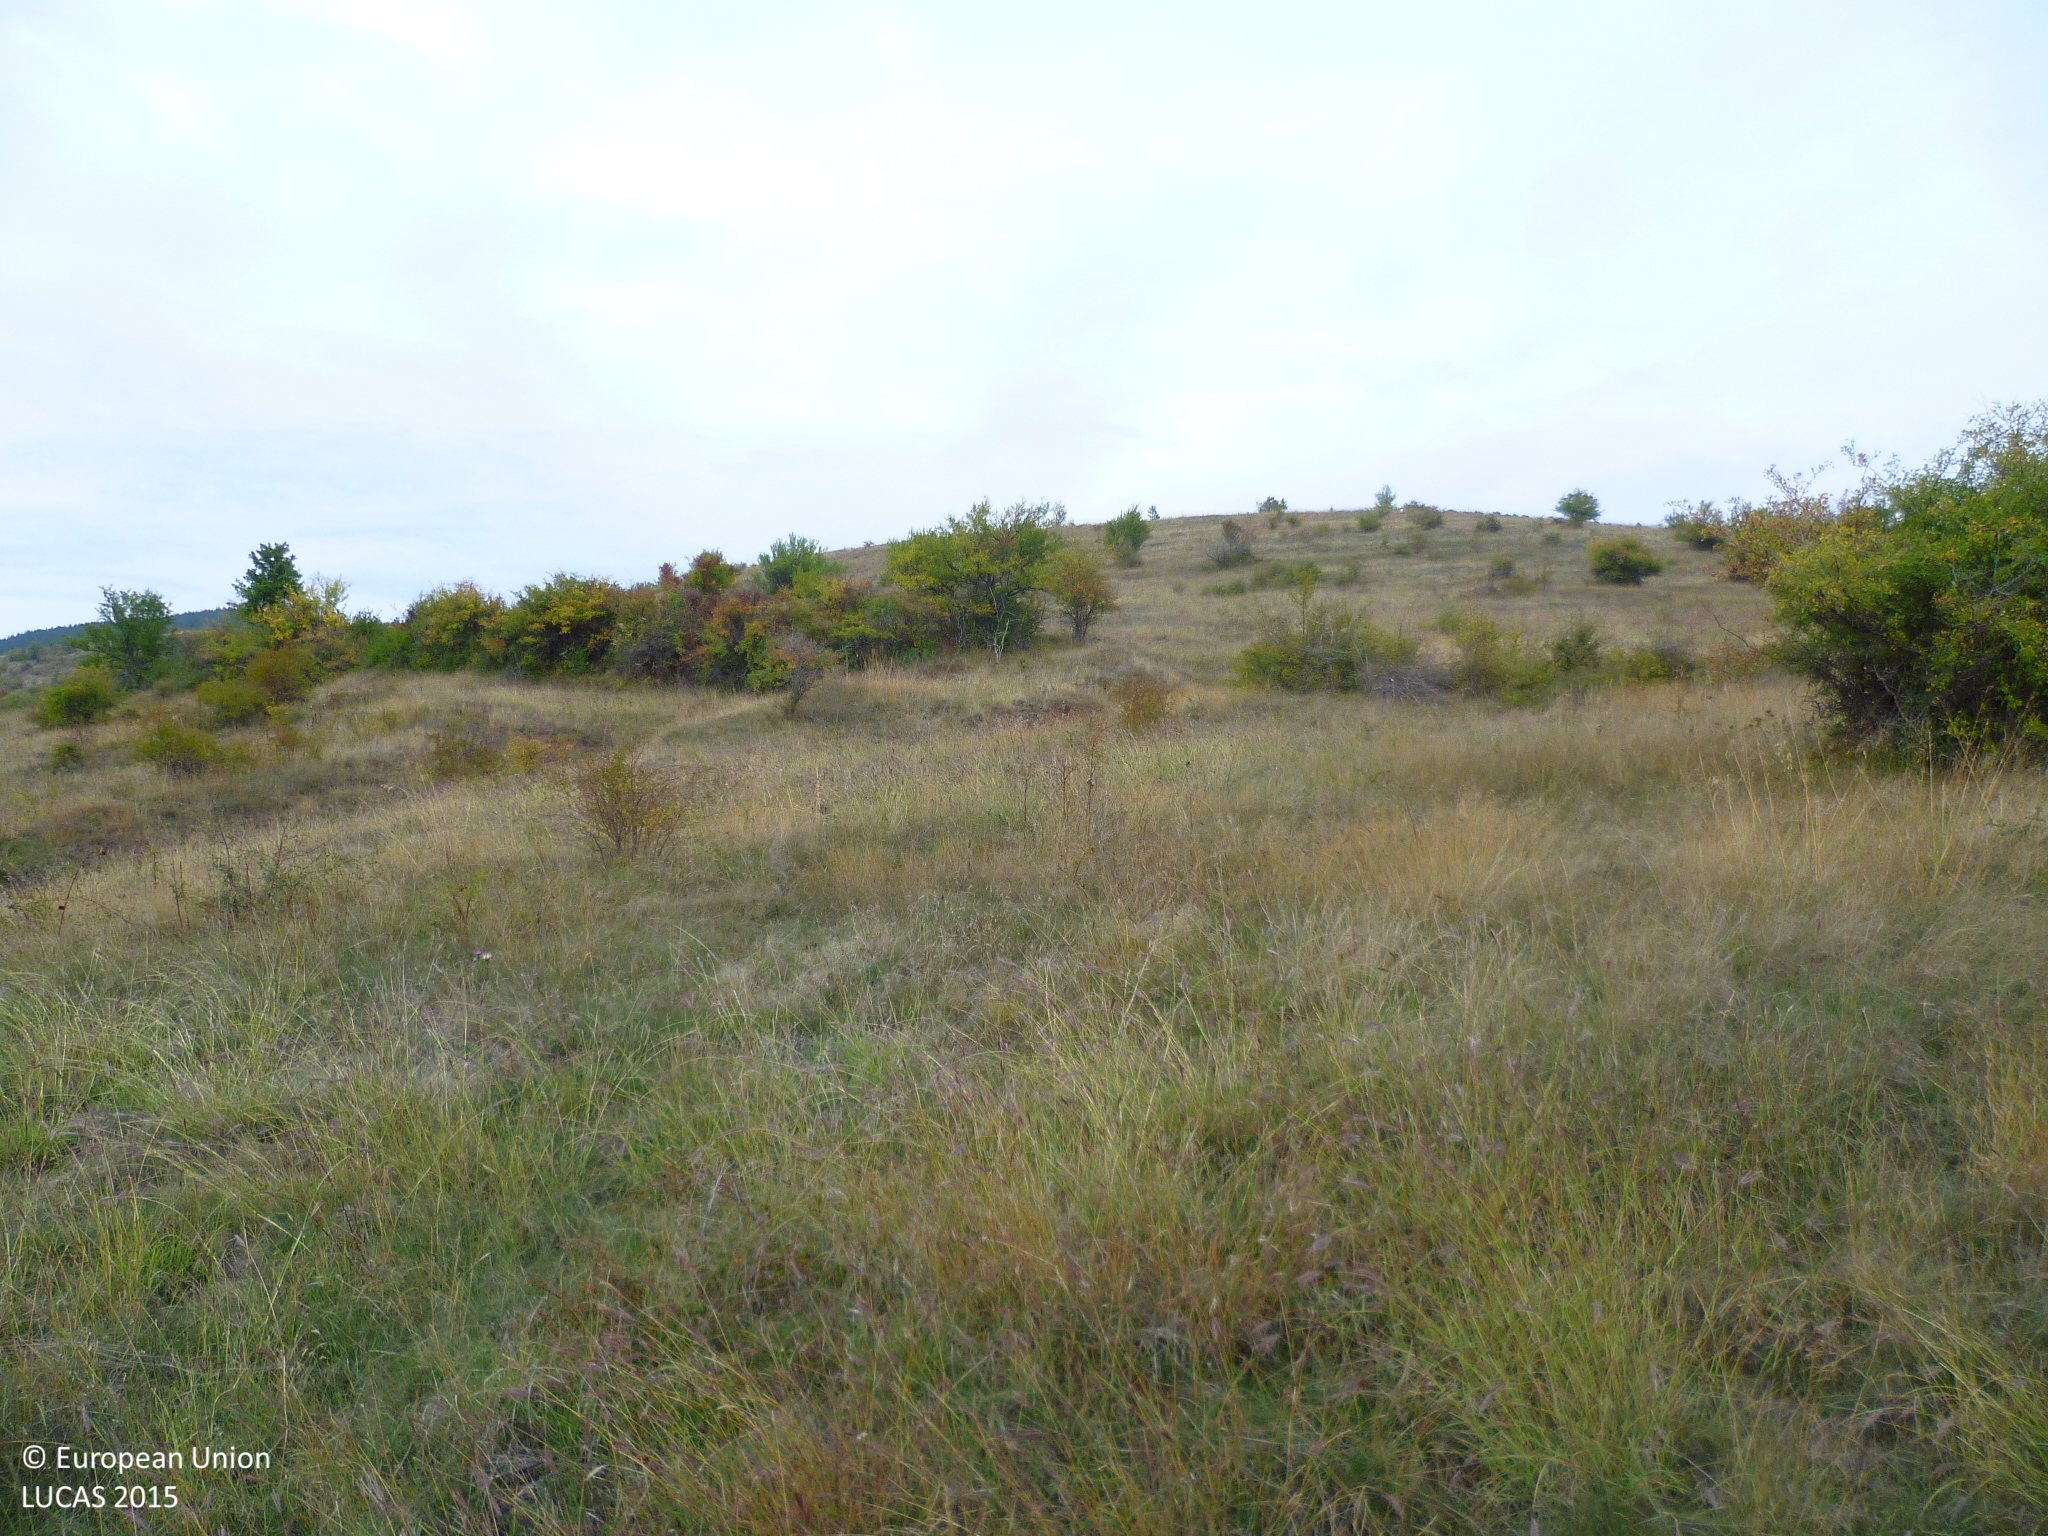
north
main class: Grassland
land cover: Grassland with sparse tree/shrub cover
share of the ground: > 75 %
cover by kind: herbaceous plants 90 %, broadleaved forest trees 5 %, shrubs 5 %
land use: Agriculture (excluding fallow land and kitchen gardens)
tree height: < 5 m
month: October
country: BG
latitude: 42.7163
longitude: 22.7873
